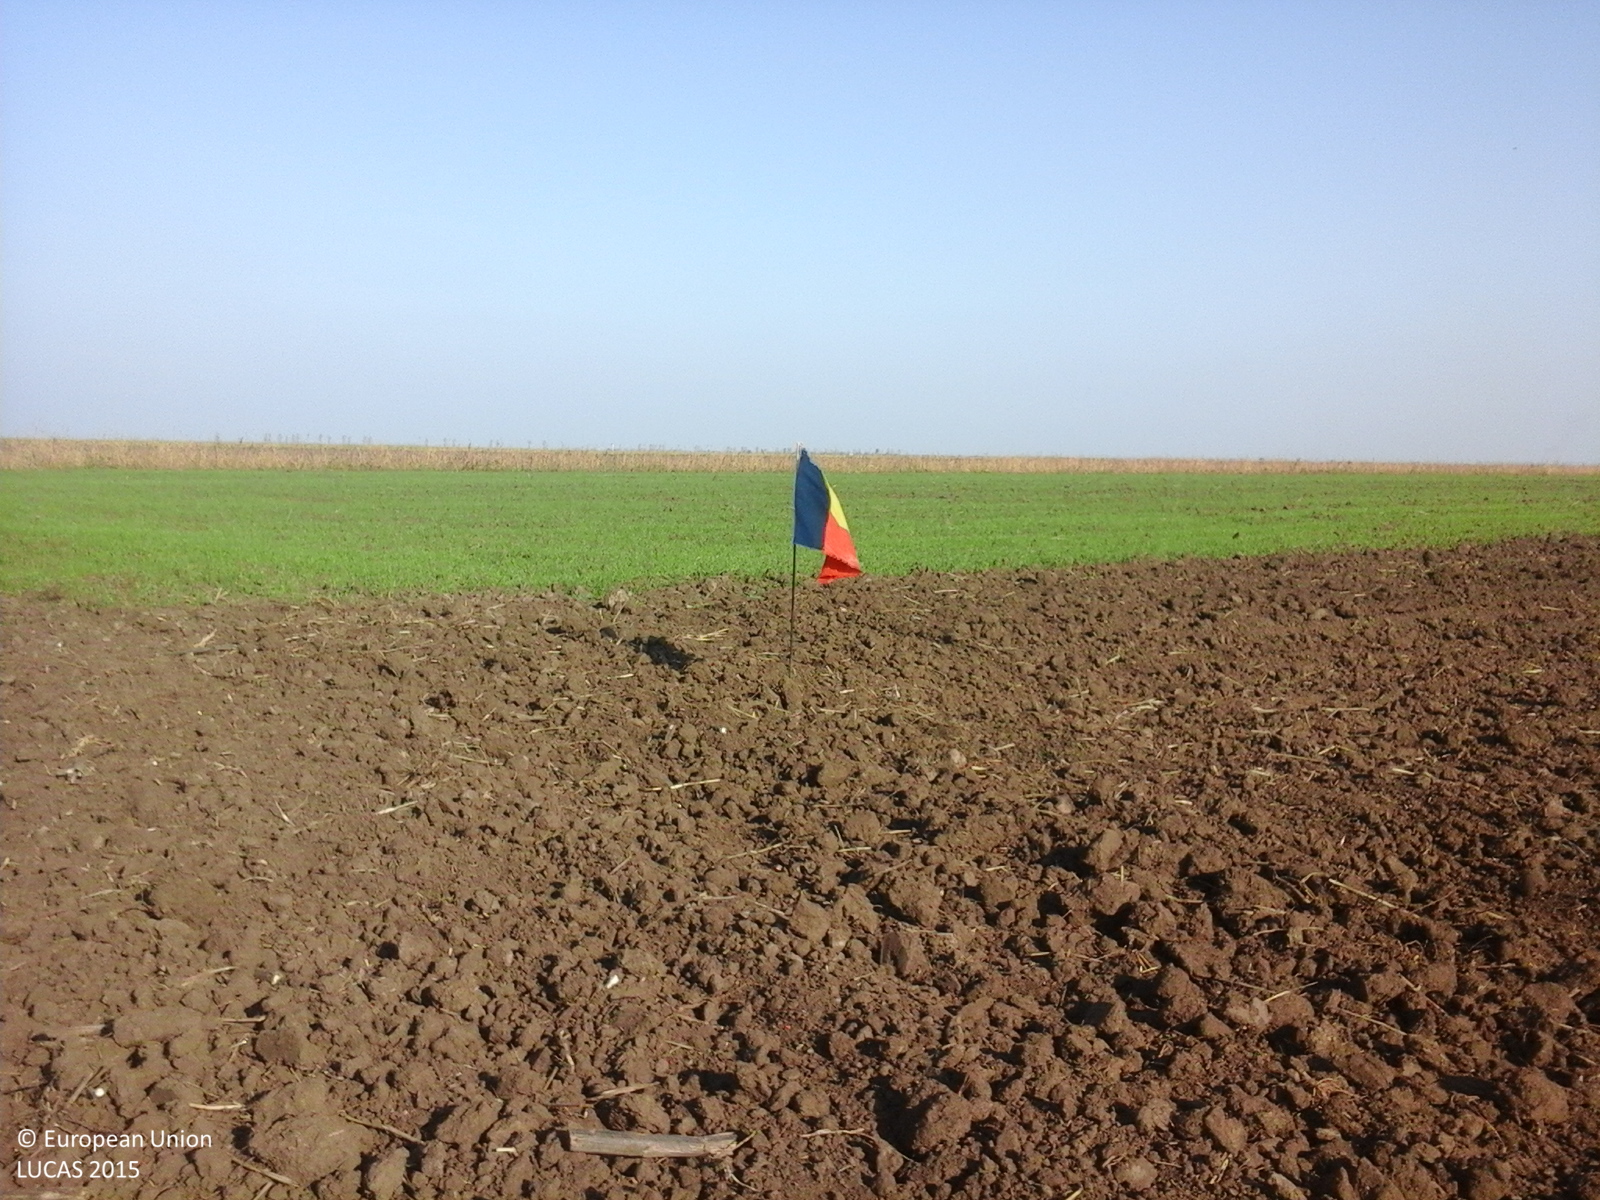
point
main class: Cropland
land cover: Common wheat
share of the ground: < 10 %
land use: Agriculture (excluding fallow land and kitchen gardens)
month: October
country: RO
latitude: 45.2005
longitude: 26.8731
